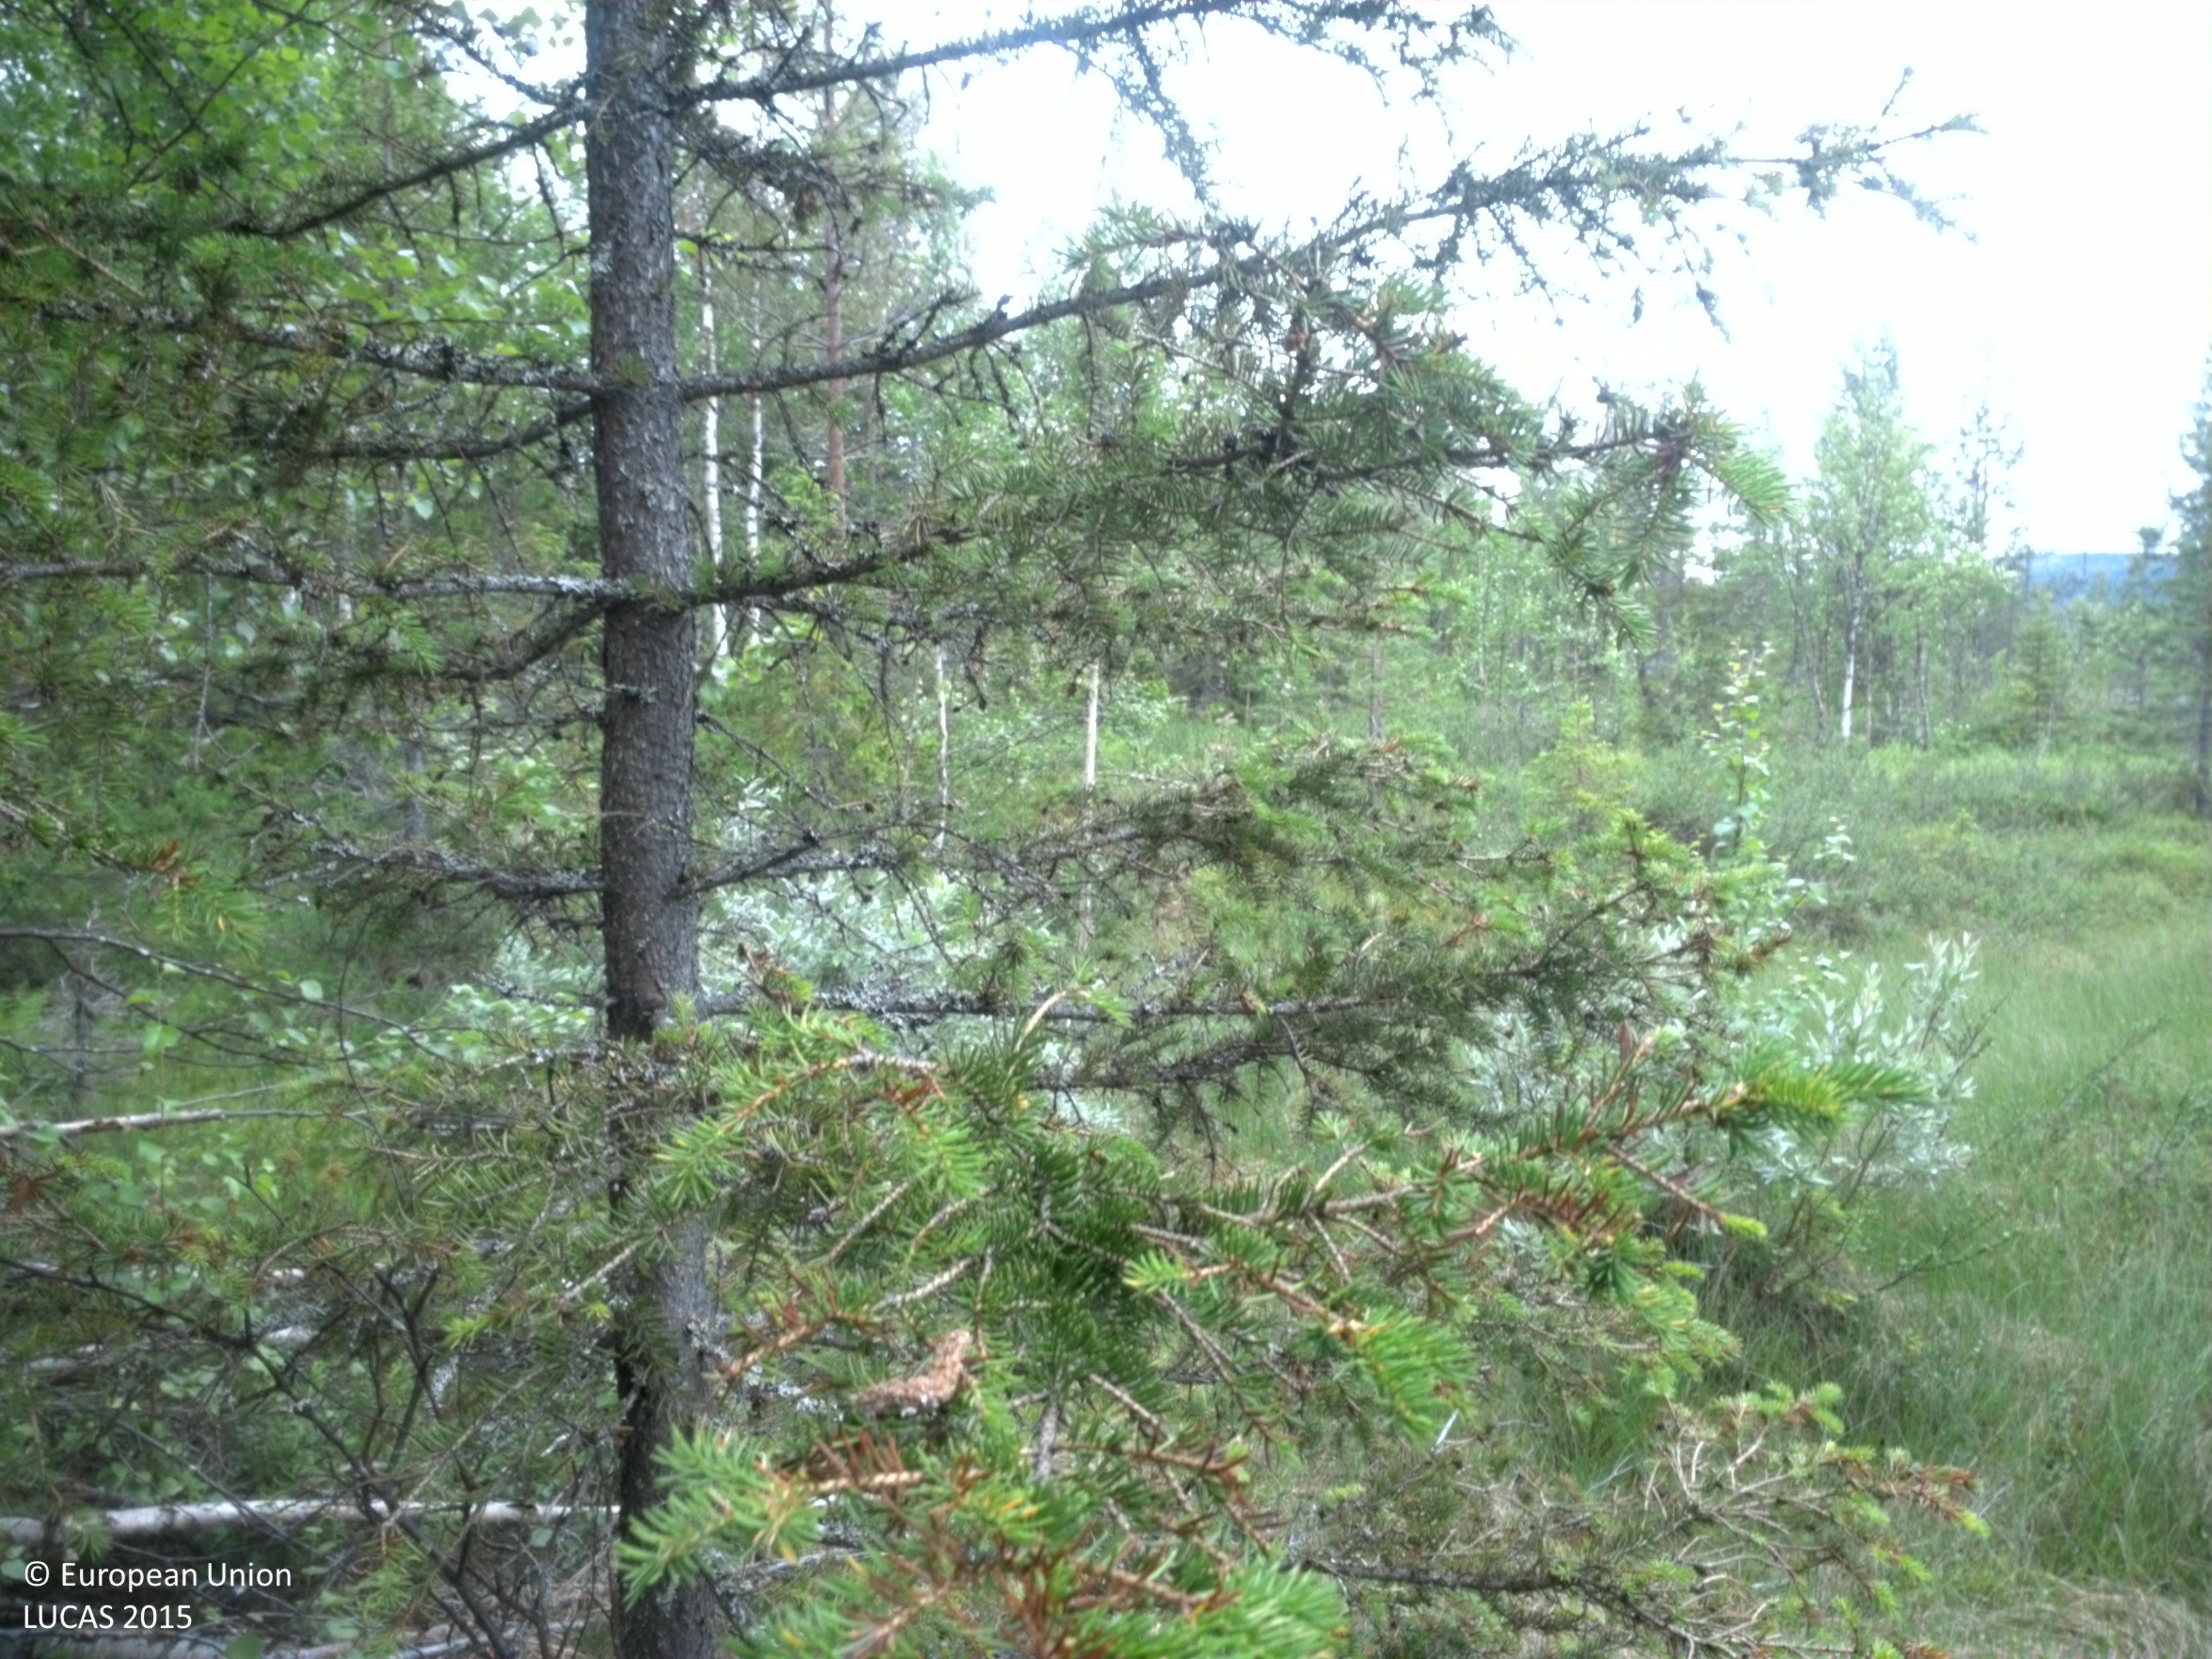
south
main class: Woodland
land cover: Pine dominated mixed woodland
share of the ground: 25 - 50 %
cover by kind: shrubs 50 %, broadleaved forest trees 30 %, coniferous forest trees 20 %
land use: Forestry
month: August
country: SE
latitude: 66.1875
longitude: 19.8786
